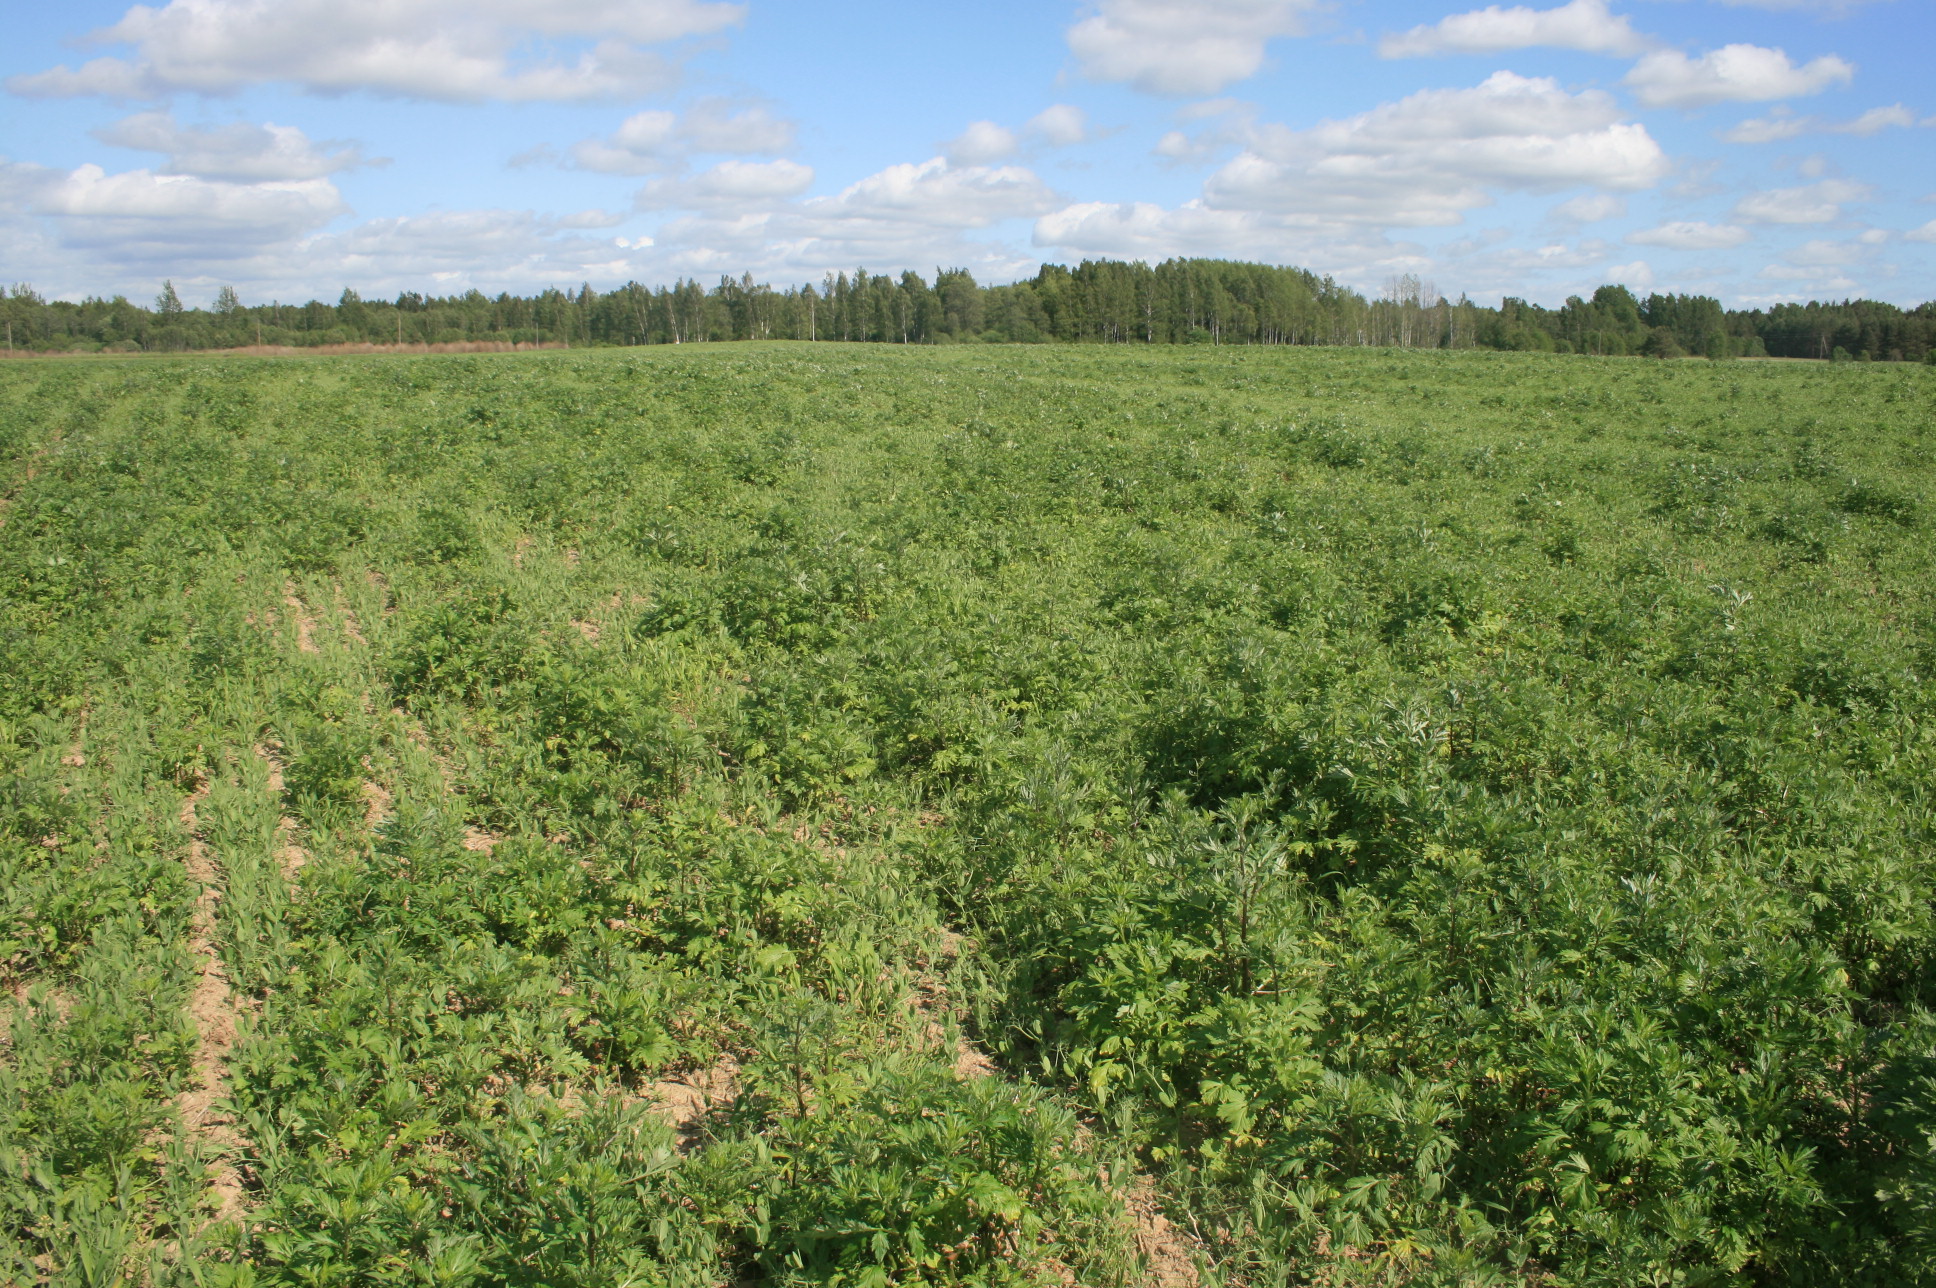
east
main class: Cropland
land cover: Dry pulses
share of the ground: > 75 %
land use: Agriculture (excluding fallow land and kitchen gardens)
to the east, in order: Dry pulses
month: June
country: LT
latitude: 56.0595
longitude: 22.3746
